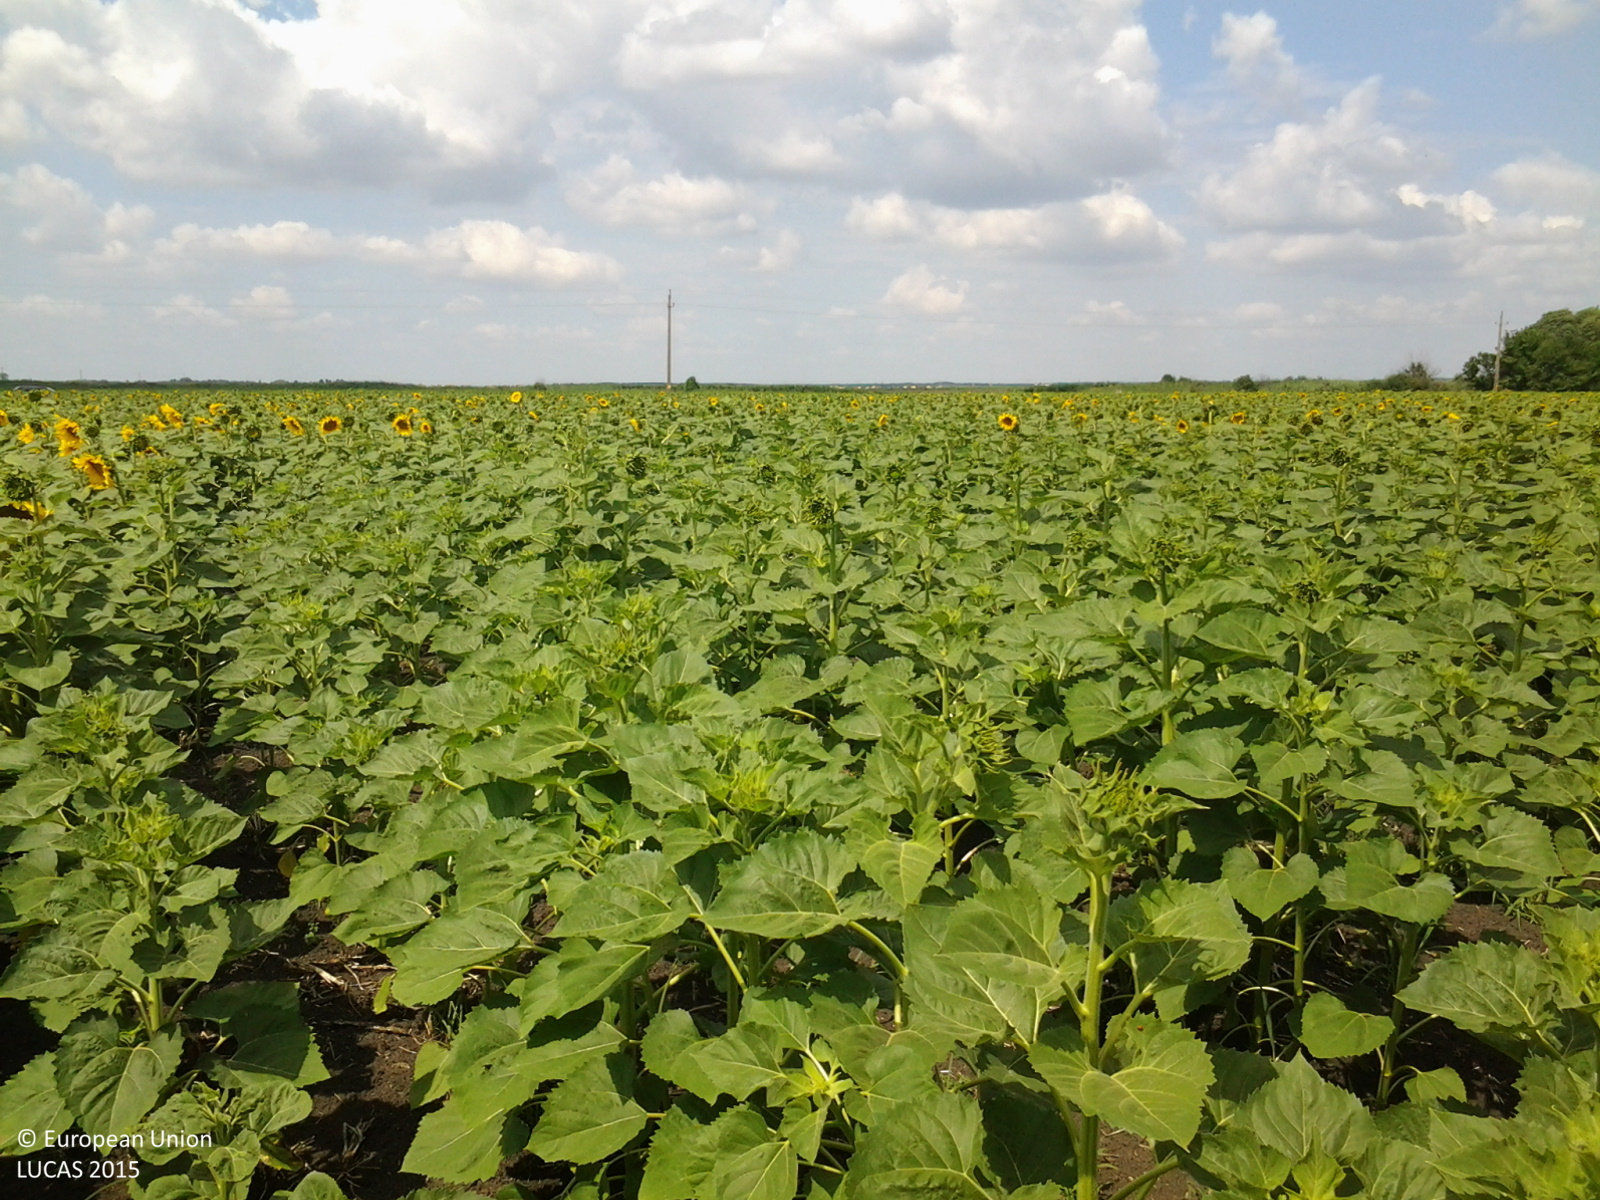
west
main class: Cropland
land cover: Sunflower
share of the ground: > 75 %
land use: Agriculture (excluding fallow land and kitchen gardens)
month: July
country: HU
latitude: 46.9200
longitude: 20.7066
